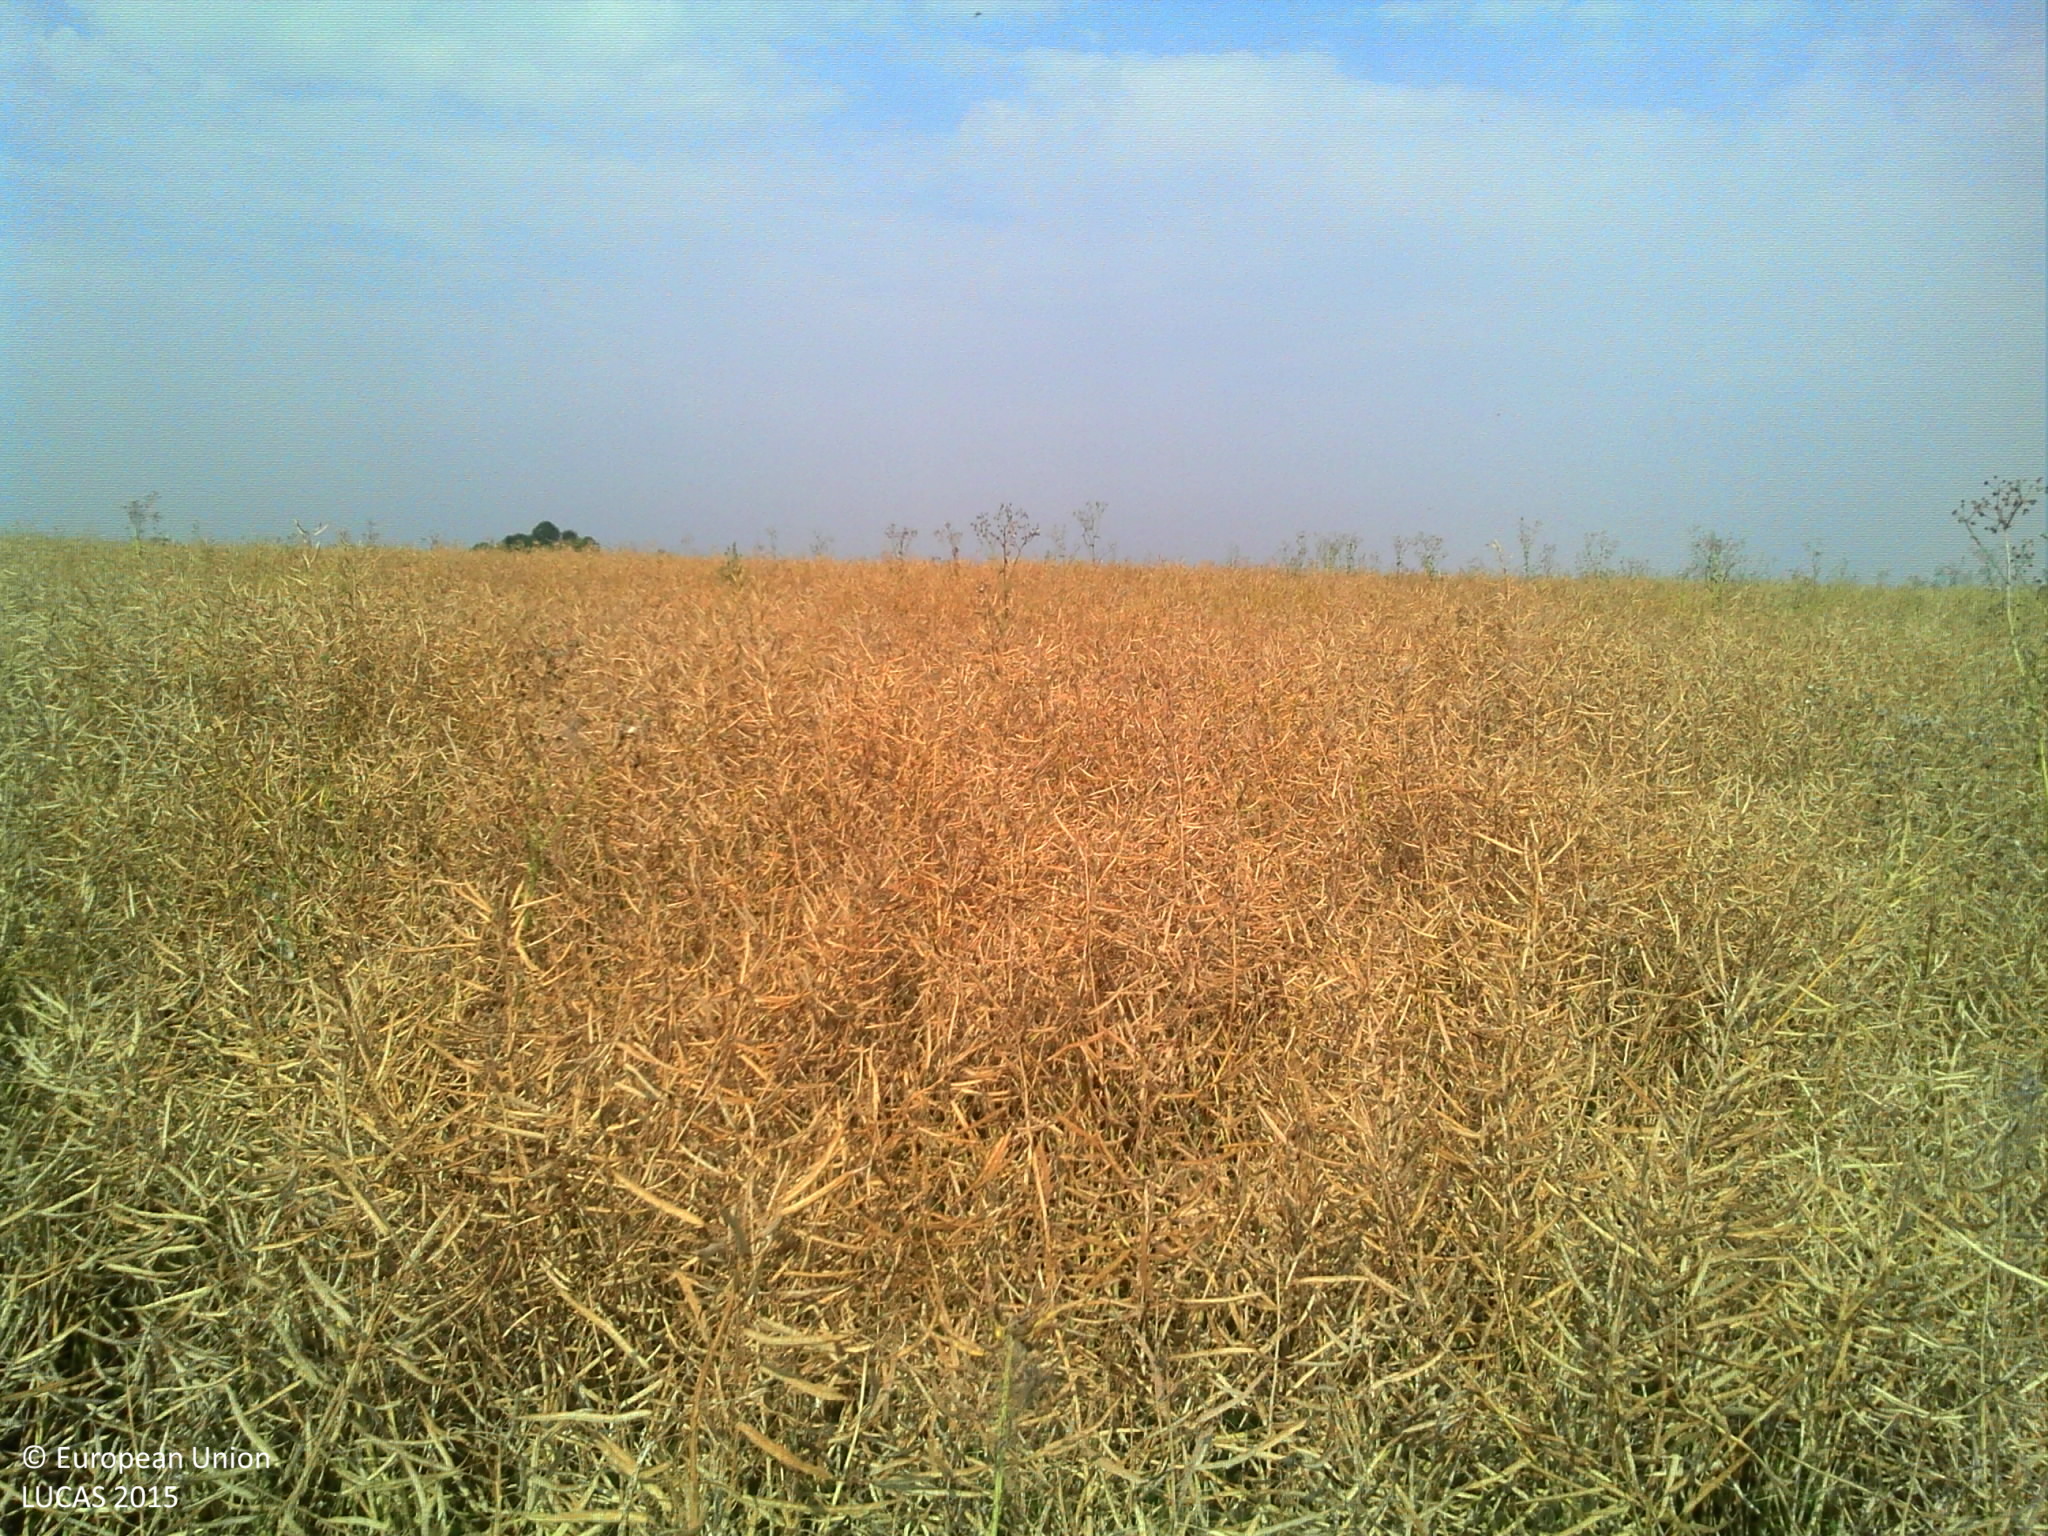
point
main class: Cropland
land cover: Rape and turnip rape
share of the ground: > 75 %
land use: Agriculture (excluding fallow land and kitchen gardens)
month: July
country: FR
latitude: 47.8463
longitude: 2.8434
